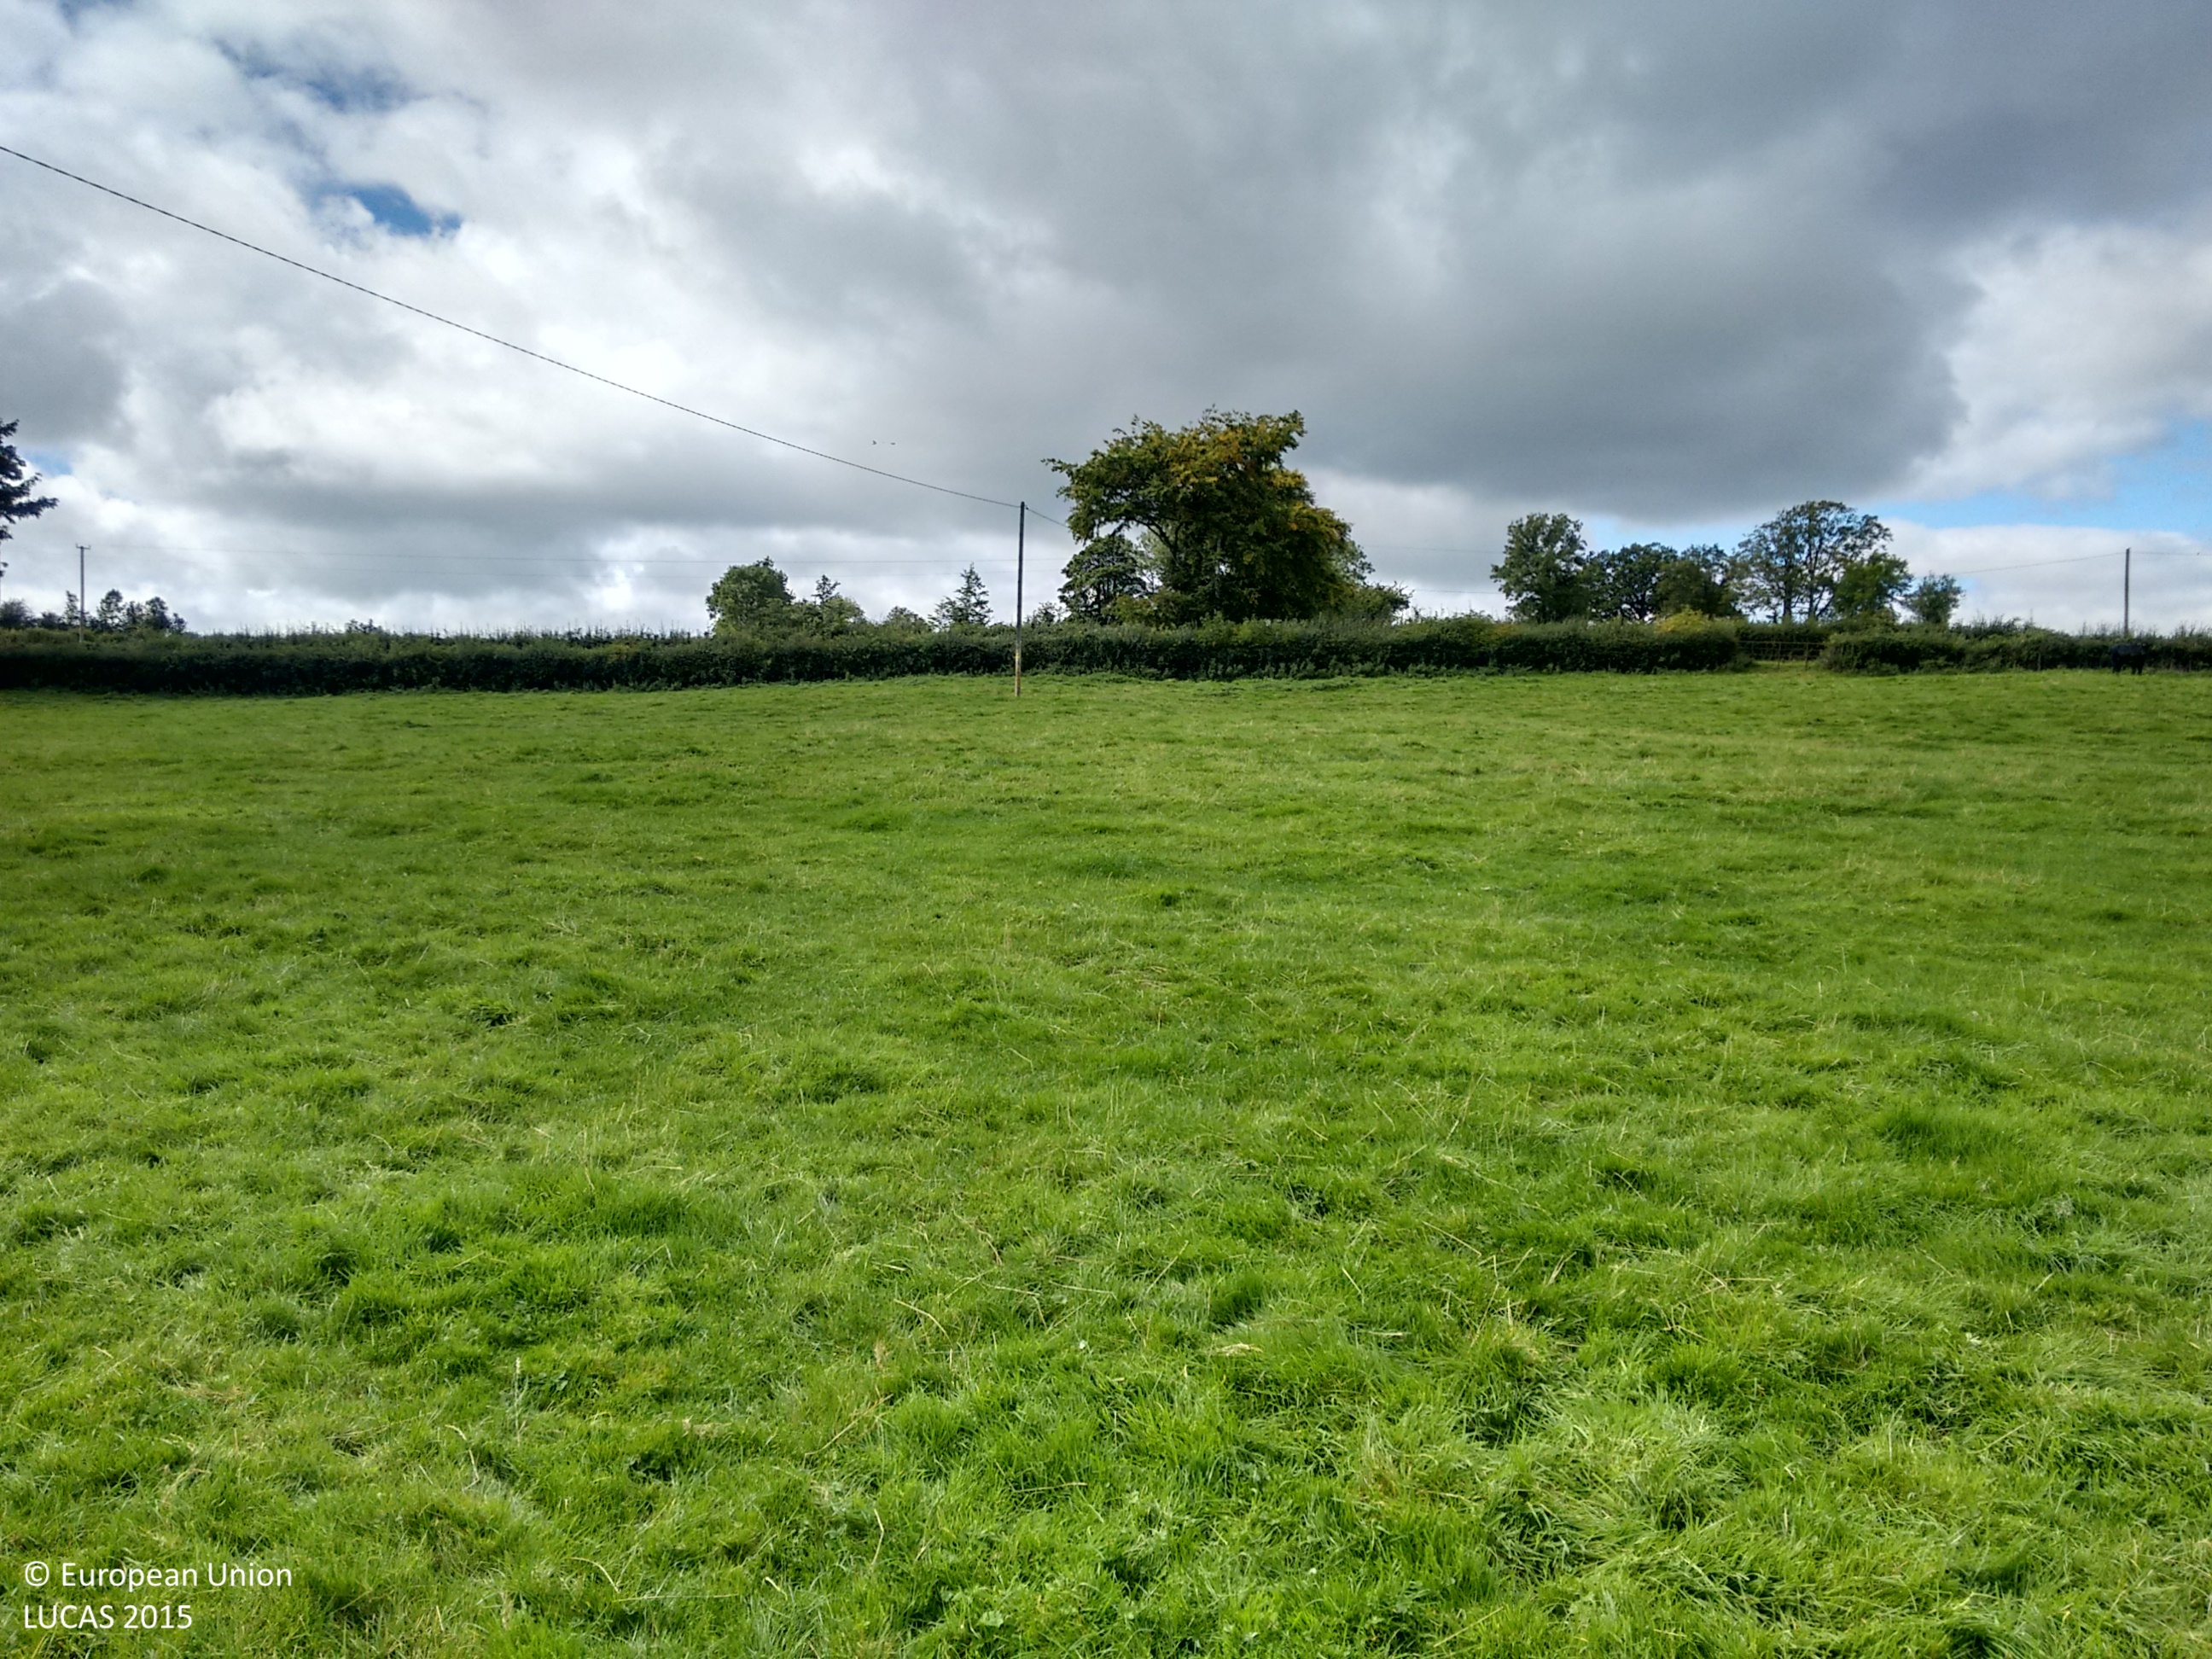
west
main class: Grassland
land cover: Grassland without tree/shrub cover
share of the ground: > 75 %
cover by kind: herbaceous plants 95 %, shrubs 5 %
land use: Agriculture (excluding fallow land and kitchen gardens)
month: September
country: IE
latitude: 54.2774
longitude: -6.9241
